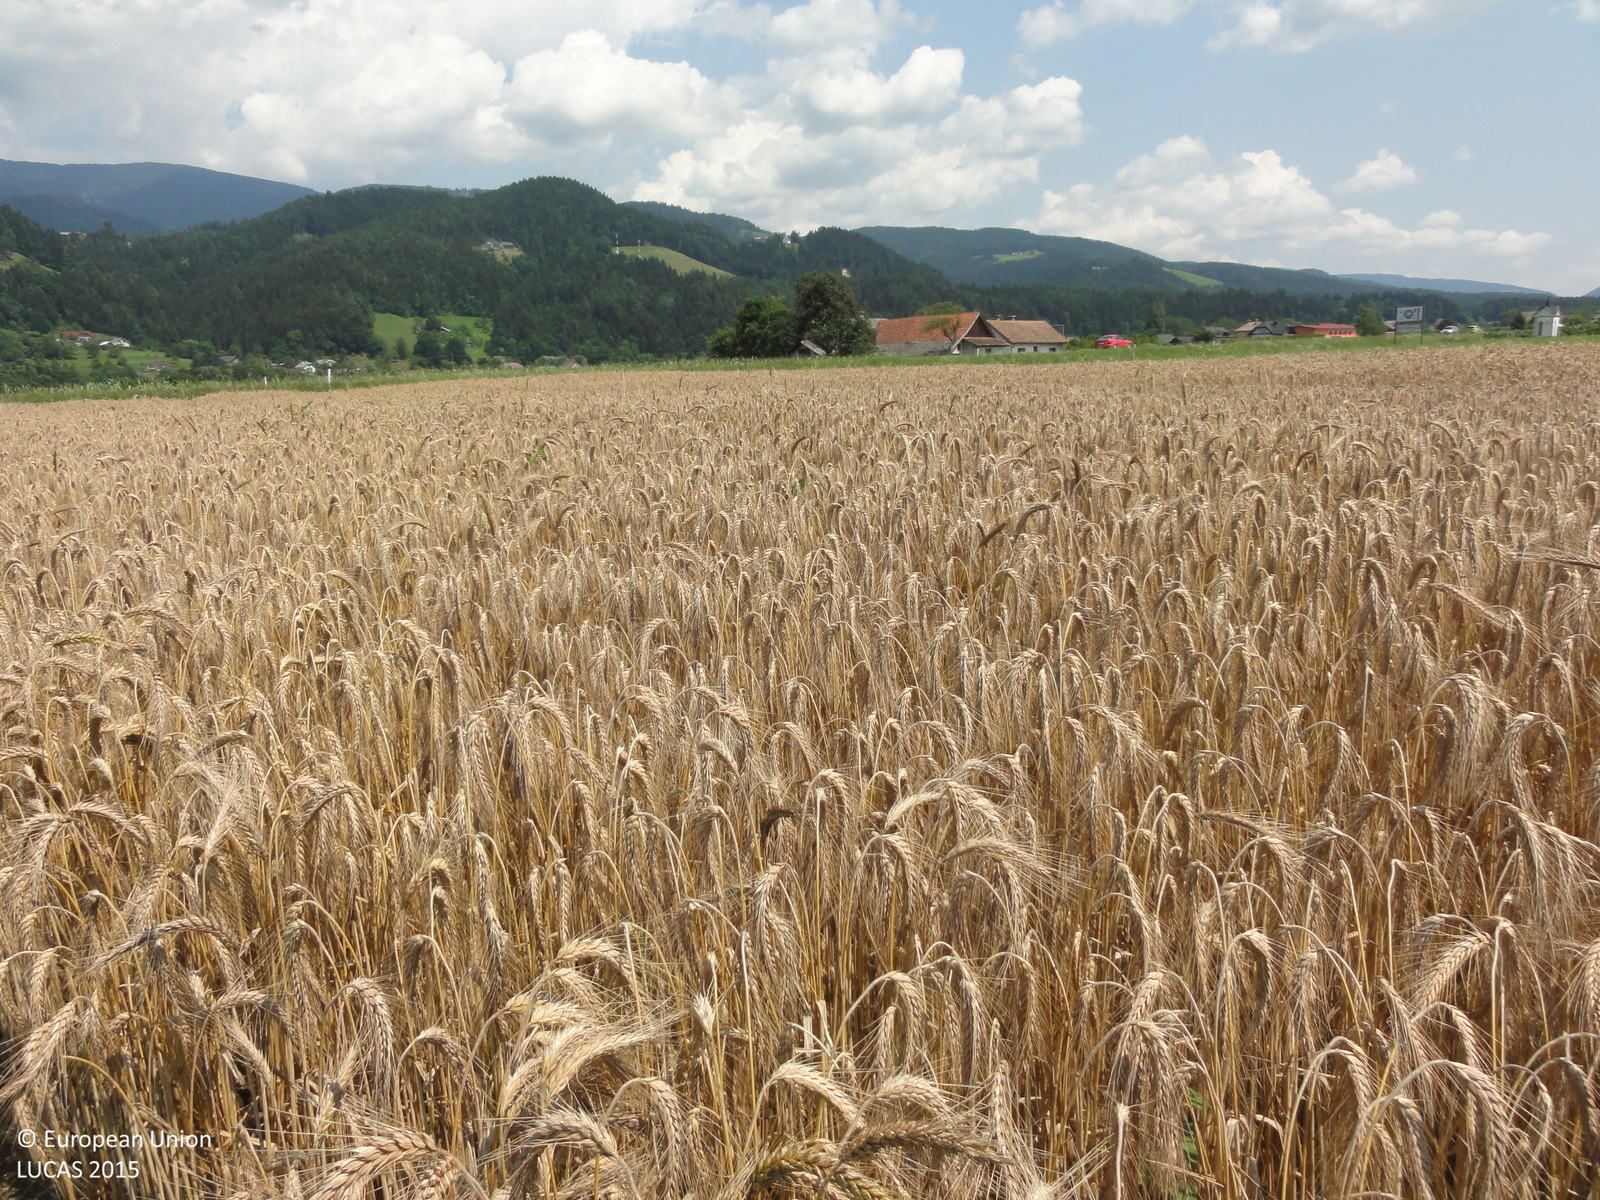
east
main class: Cropland
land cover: Common wheat
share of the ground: > 75 %
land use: Agriculture (excluding fallow land and kitchen gardens)
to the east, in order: Common wheat; Grass margins; Paved roads, cycling and walking lanes; Grassland without tree/shrub cover; Maize; Grassland without tree/shrub cover; Artificial constructions in urban areas; Grassland without tree/shrub cover; Maize; Grassland without tree/shrub cover; Ditches and canals; Grass margins; Tracks
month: July
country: SI
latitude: 46.4814
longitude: 15.1172
